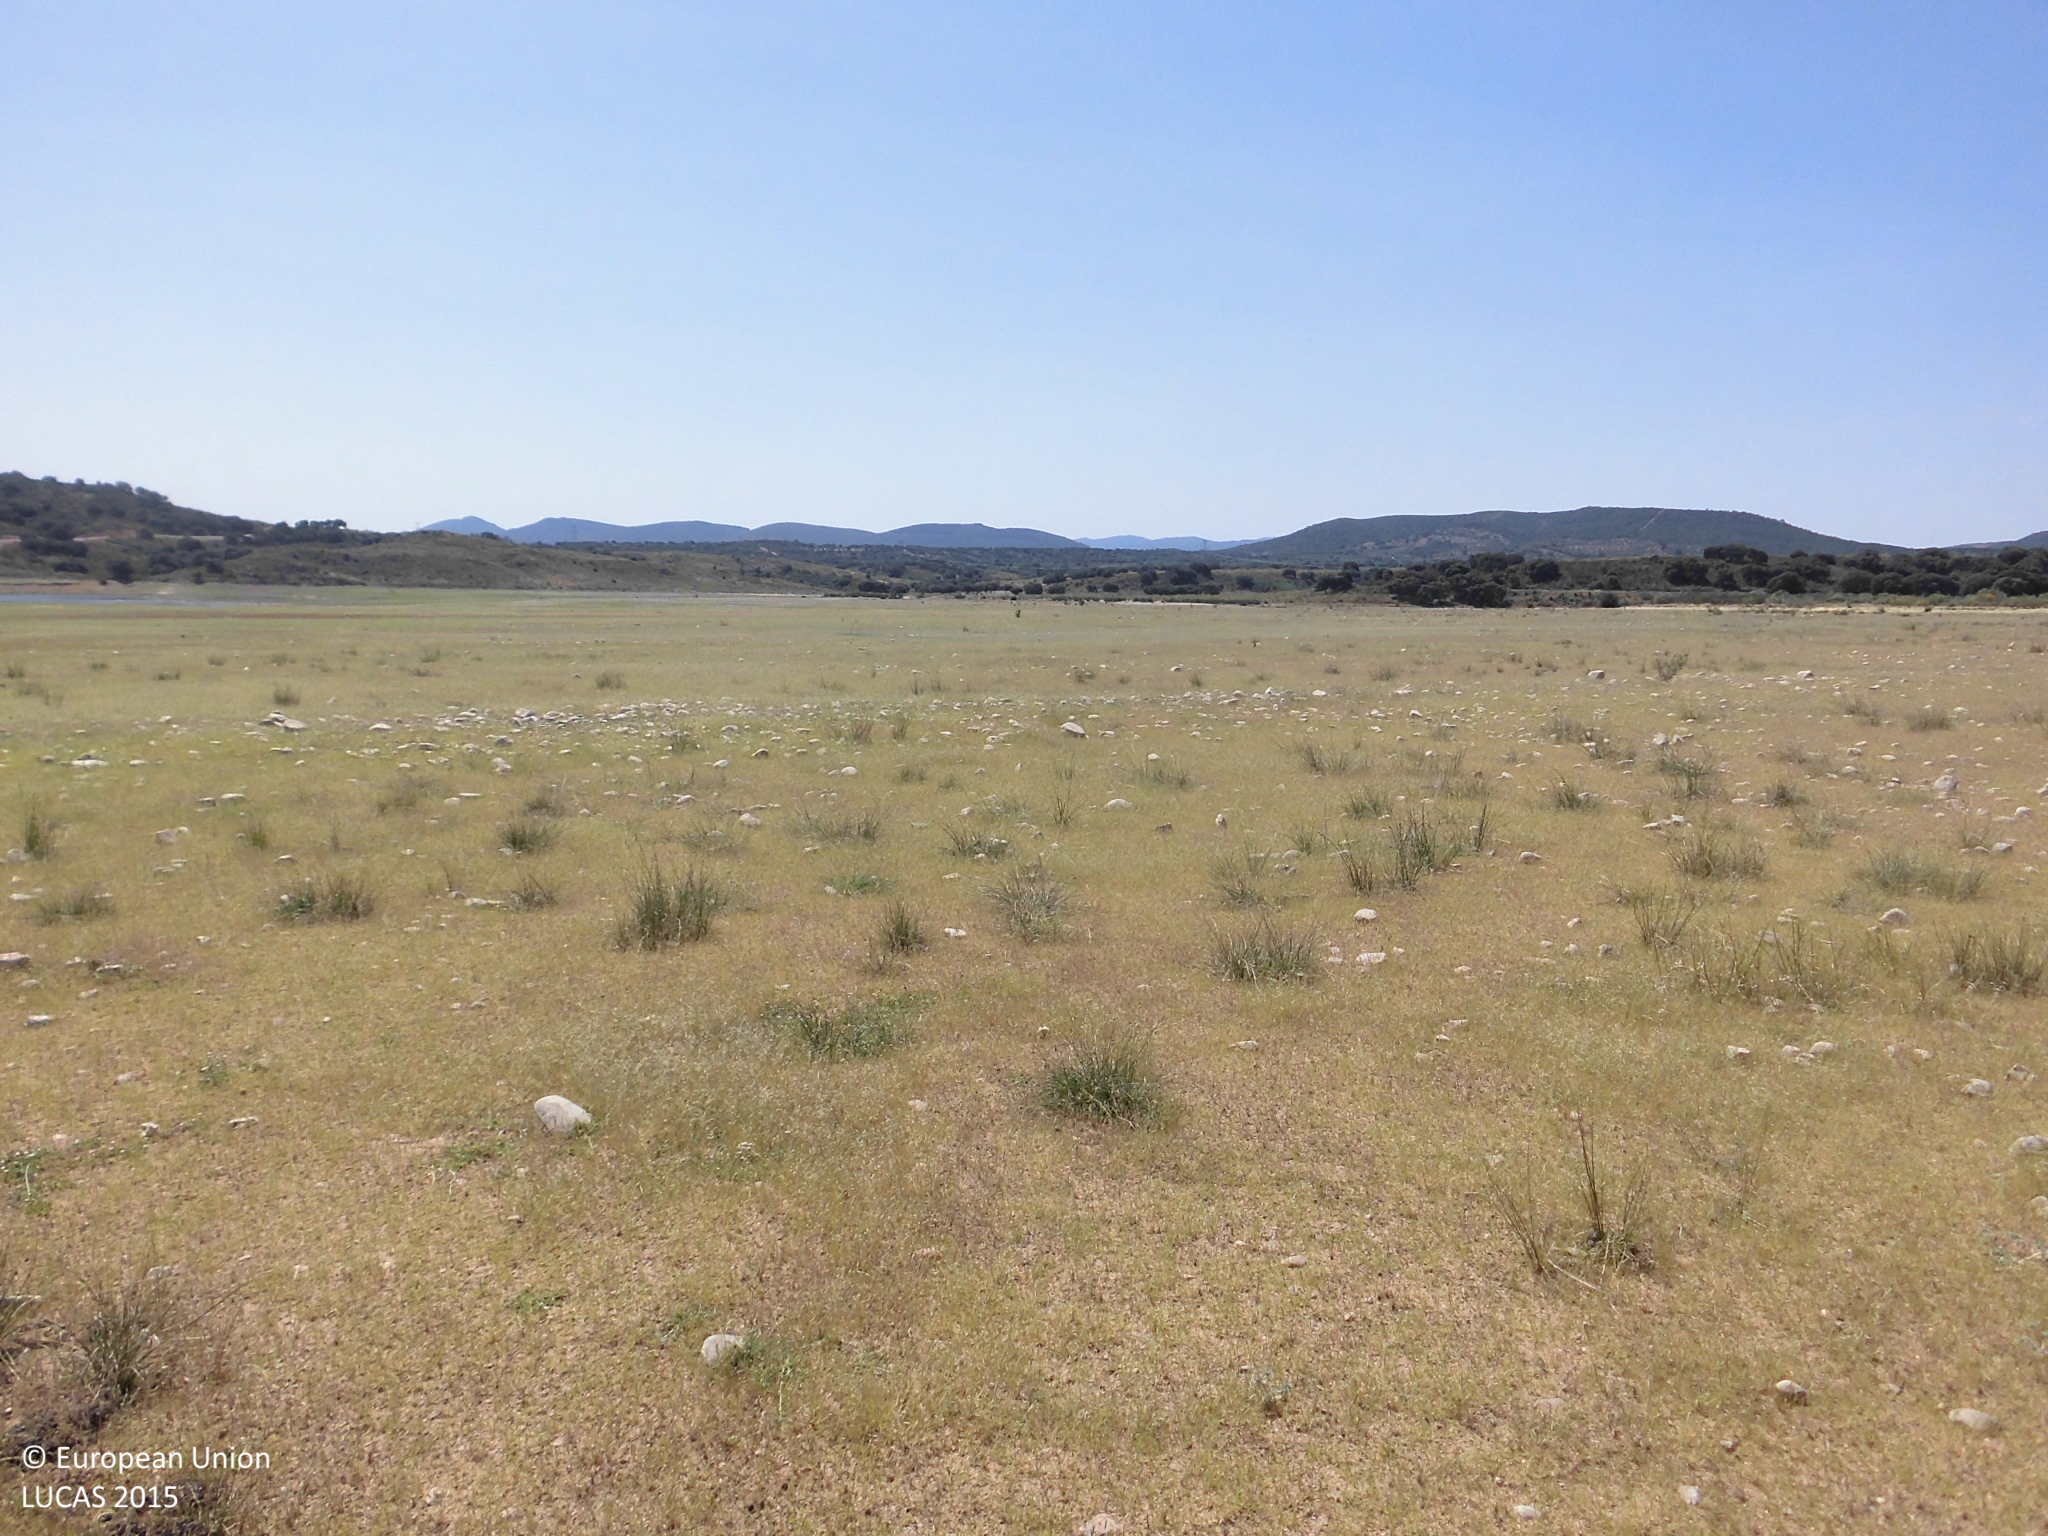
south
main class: Grassland
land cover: Spontaneously vegetated surfaces
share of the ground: > 75 %
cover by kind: herbaceous plants 100 %
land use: Semi-natural and natural areas not in use
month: July
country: ES
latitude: 39.7876
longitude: -5.4579
